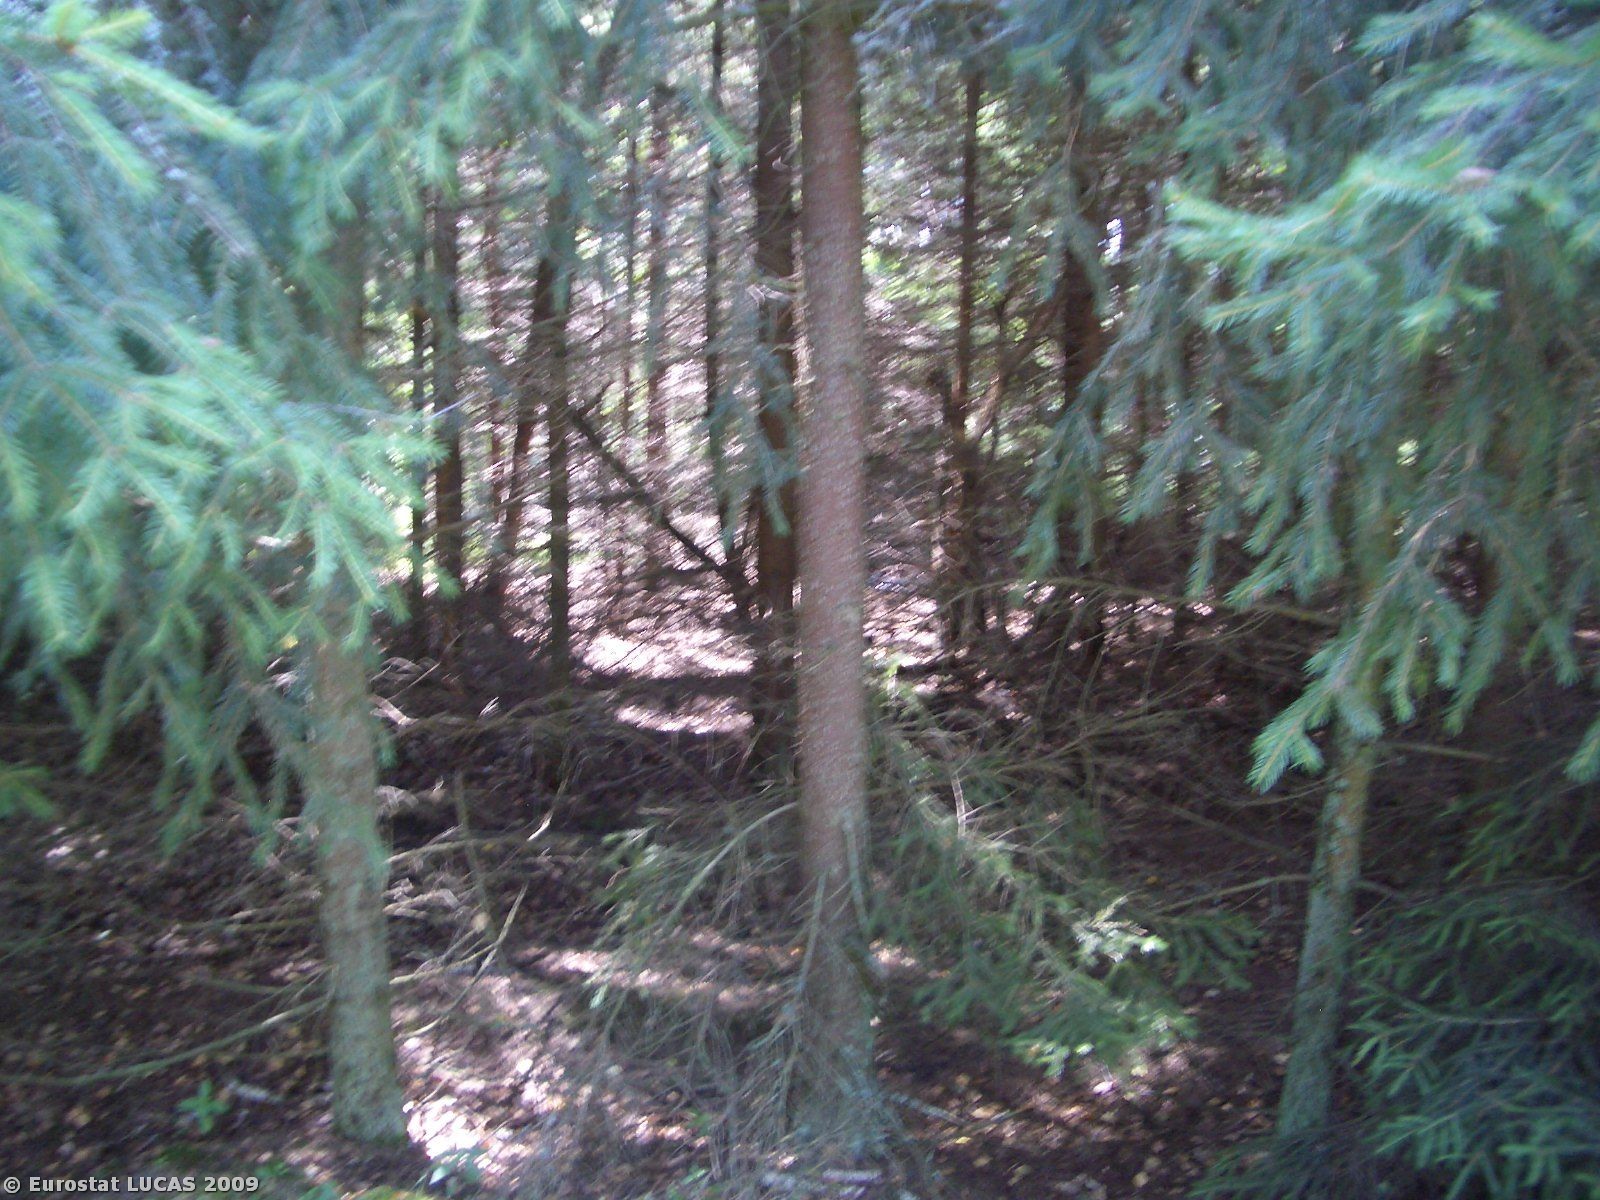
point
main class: Woodland
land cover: Mixed woodland
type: hemiboreal forest and nemoral coniferous forest and mixed broadleaved-coniferous forest
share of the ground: > 75 %
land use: Forestry
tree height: > 5 m
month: July
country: PL
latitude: 51.5177
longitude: 23.1193
